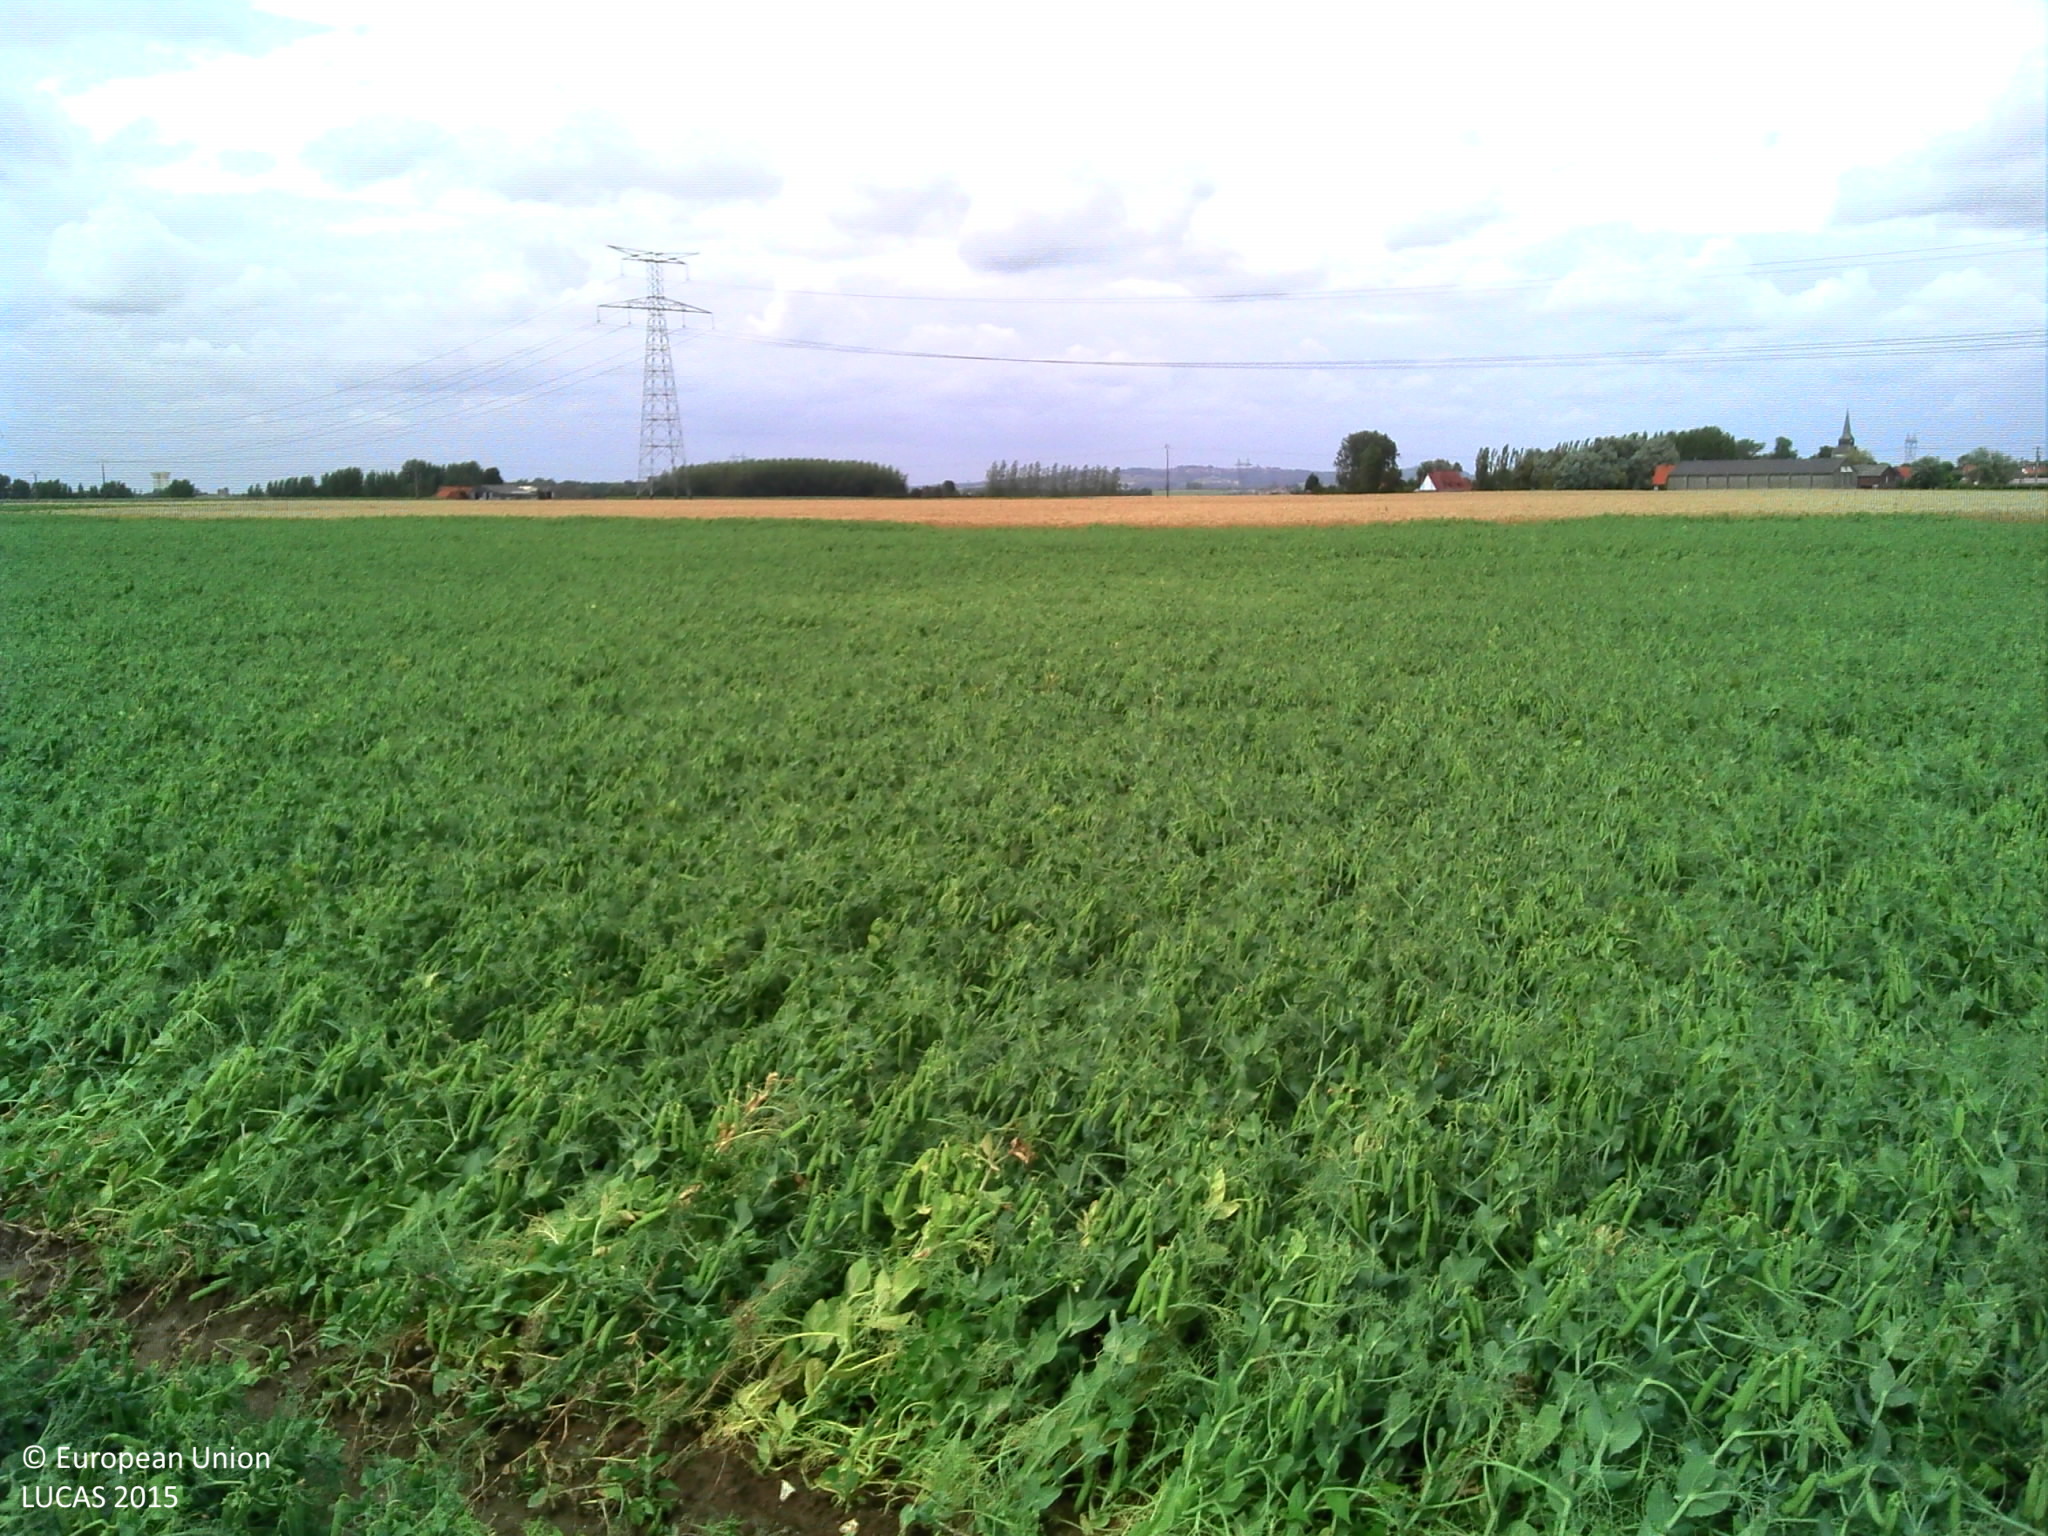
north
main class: Cropland
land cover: Dry pulses
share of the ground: > 75 %
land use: Agriculture (excluding fallow land and kitchen gardens)
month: July
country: FR
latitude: 50.7078
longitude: 2.4108
